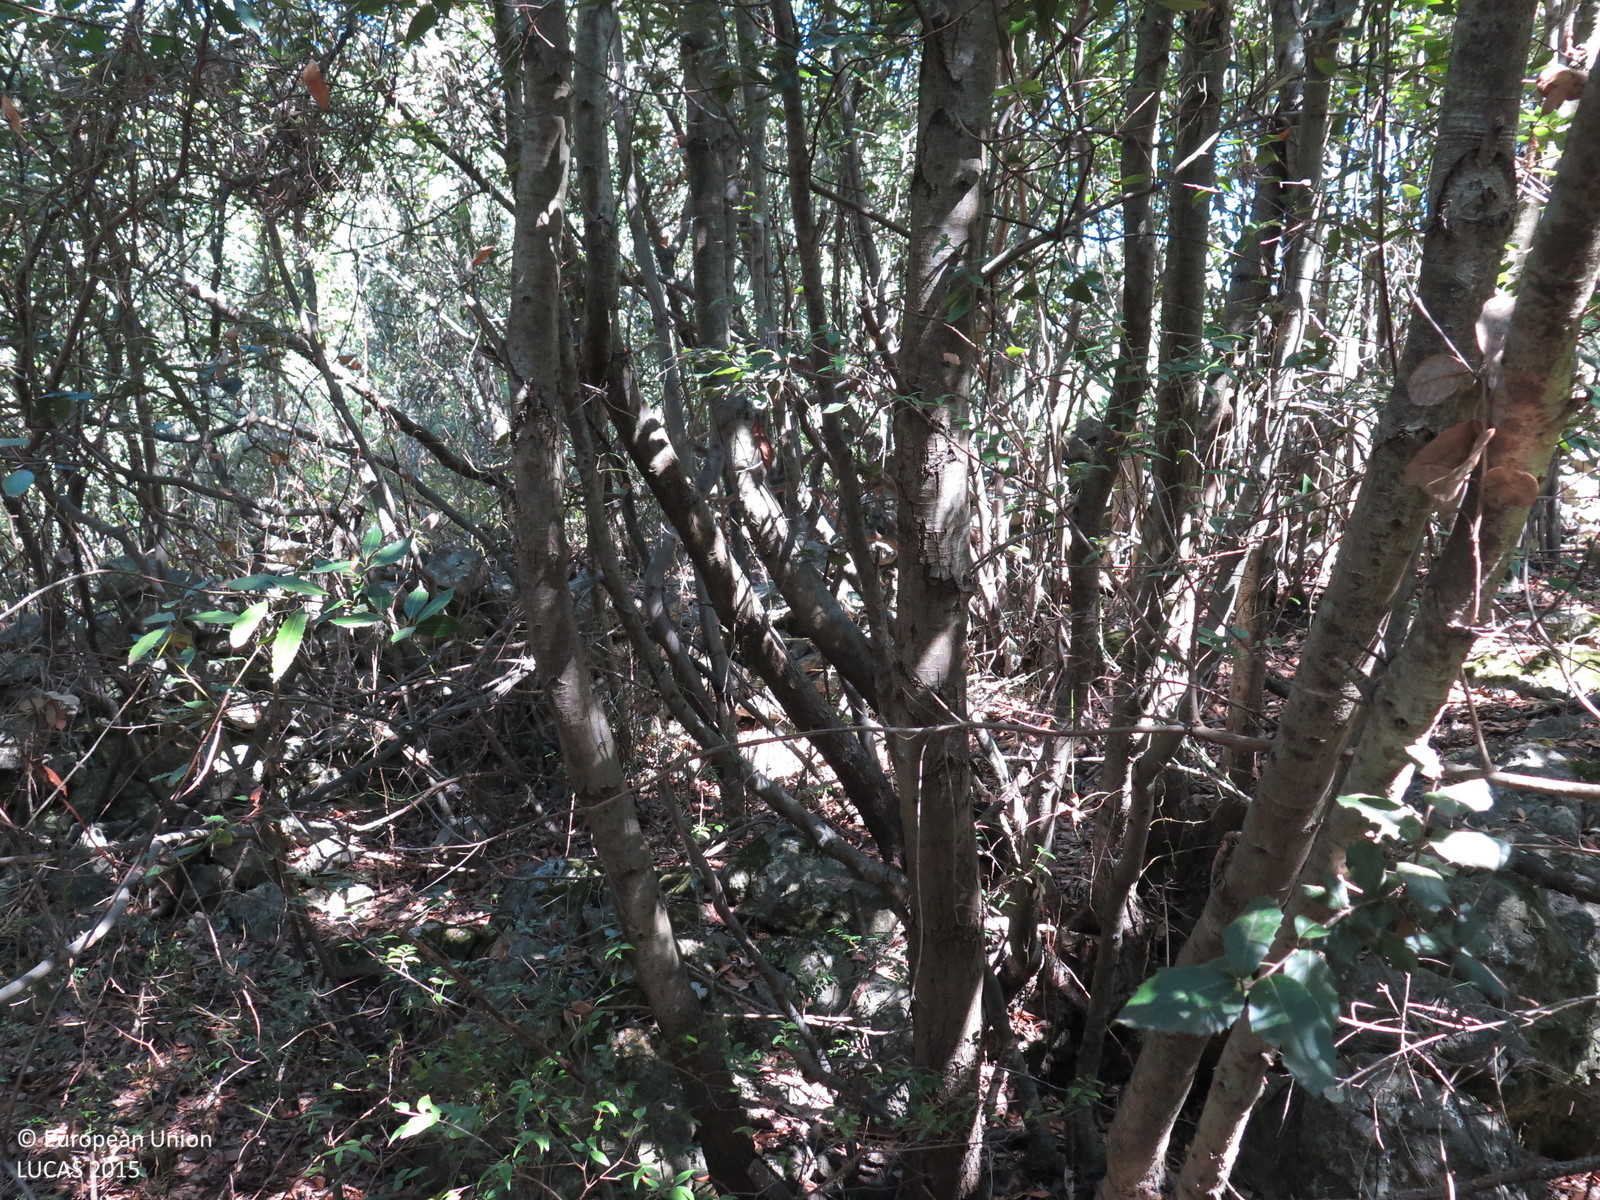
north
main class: Woodland
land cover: Broadleaved woodland
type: thermophilous deciduous forest
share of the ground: > 75 %
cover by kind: broadleaved forest trees 90 %, shrubs 5 %, herbaceous plants 5 %
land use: Semi-natural and natural areas not in use
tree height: < 5 m
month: September
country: HR
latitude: 44.6325
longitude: 14.4935
